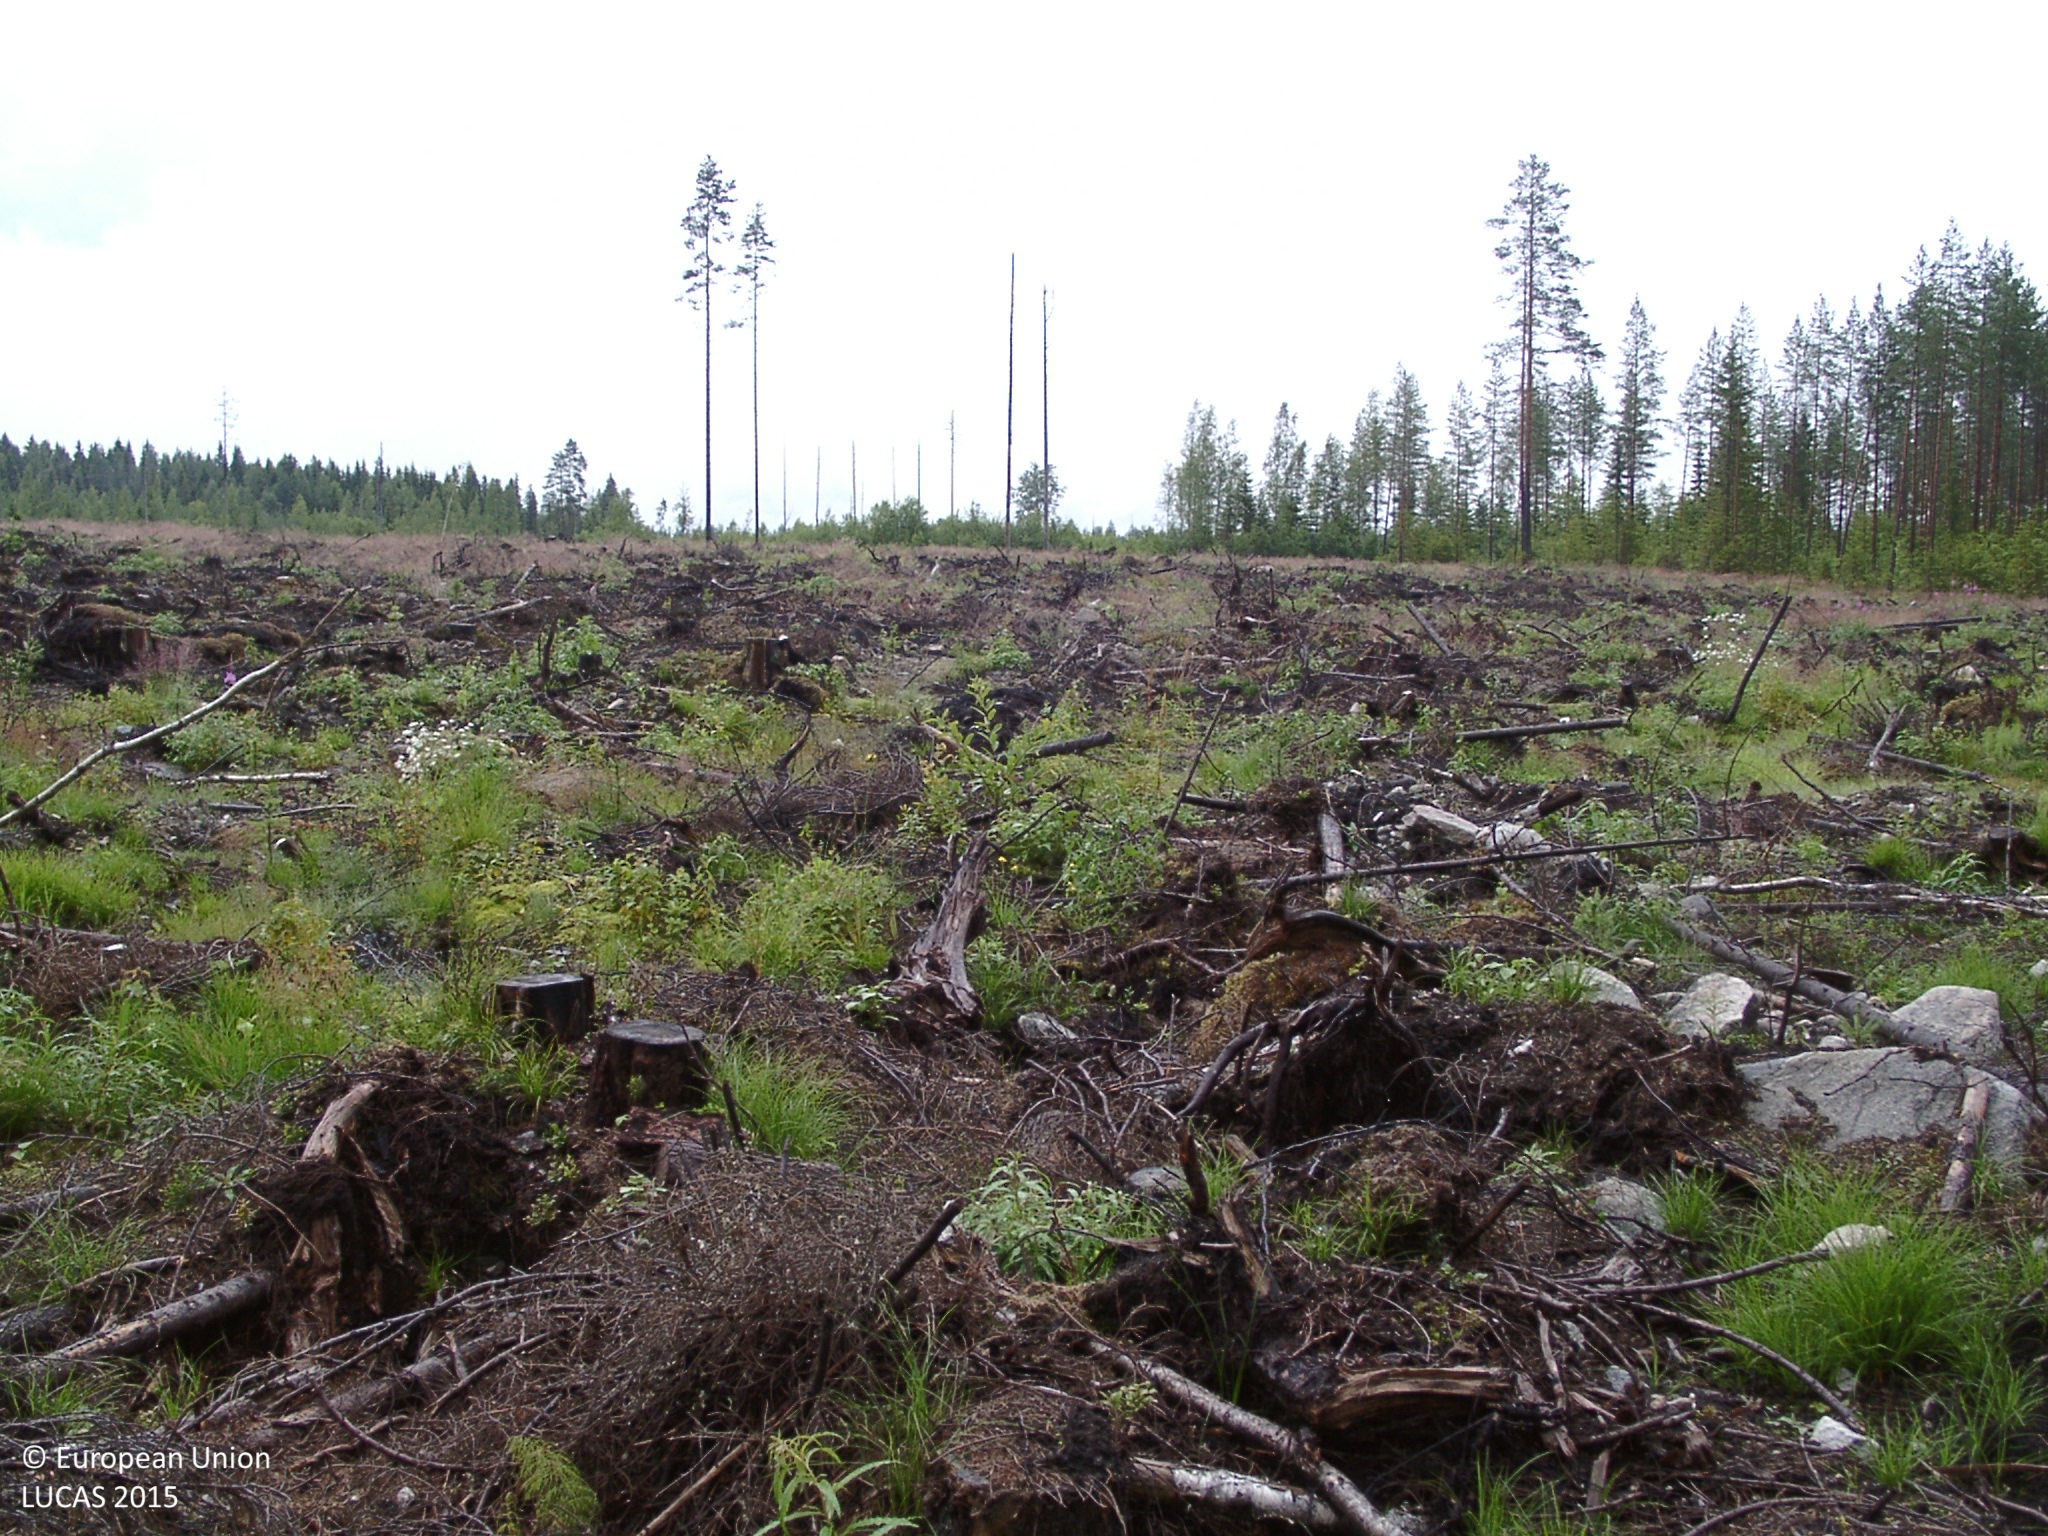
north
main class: Grassland
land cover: Grassland with sparse tree/shrub cover
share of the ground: 25 - 50 %
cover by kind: herbaceous plants 25 %, unconsolidated bare surface 25 %, lichens and mosses 10 %, broadleaved forest trees 5 %
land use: Forestry
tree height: < 5 m
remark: Nursery
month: August
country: FI
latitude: 62.8128
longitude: 24.6264
